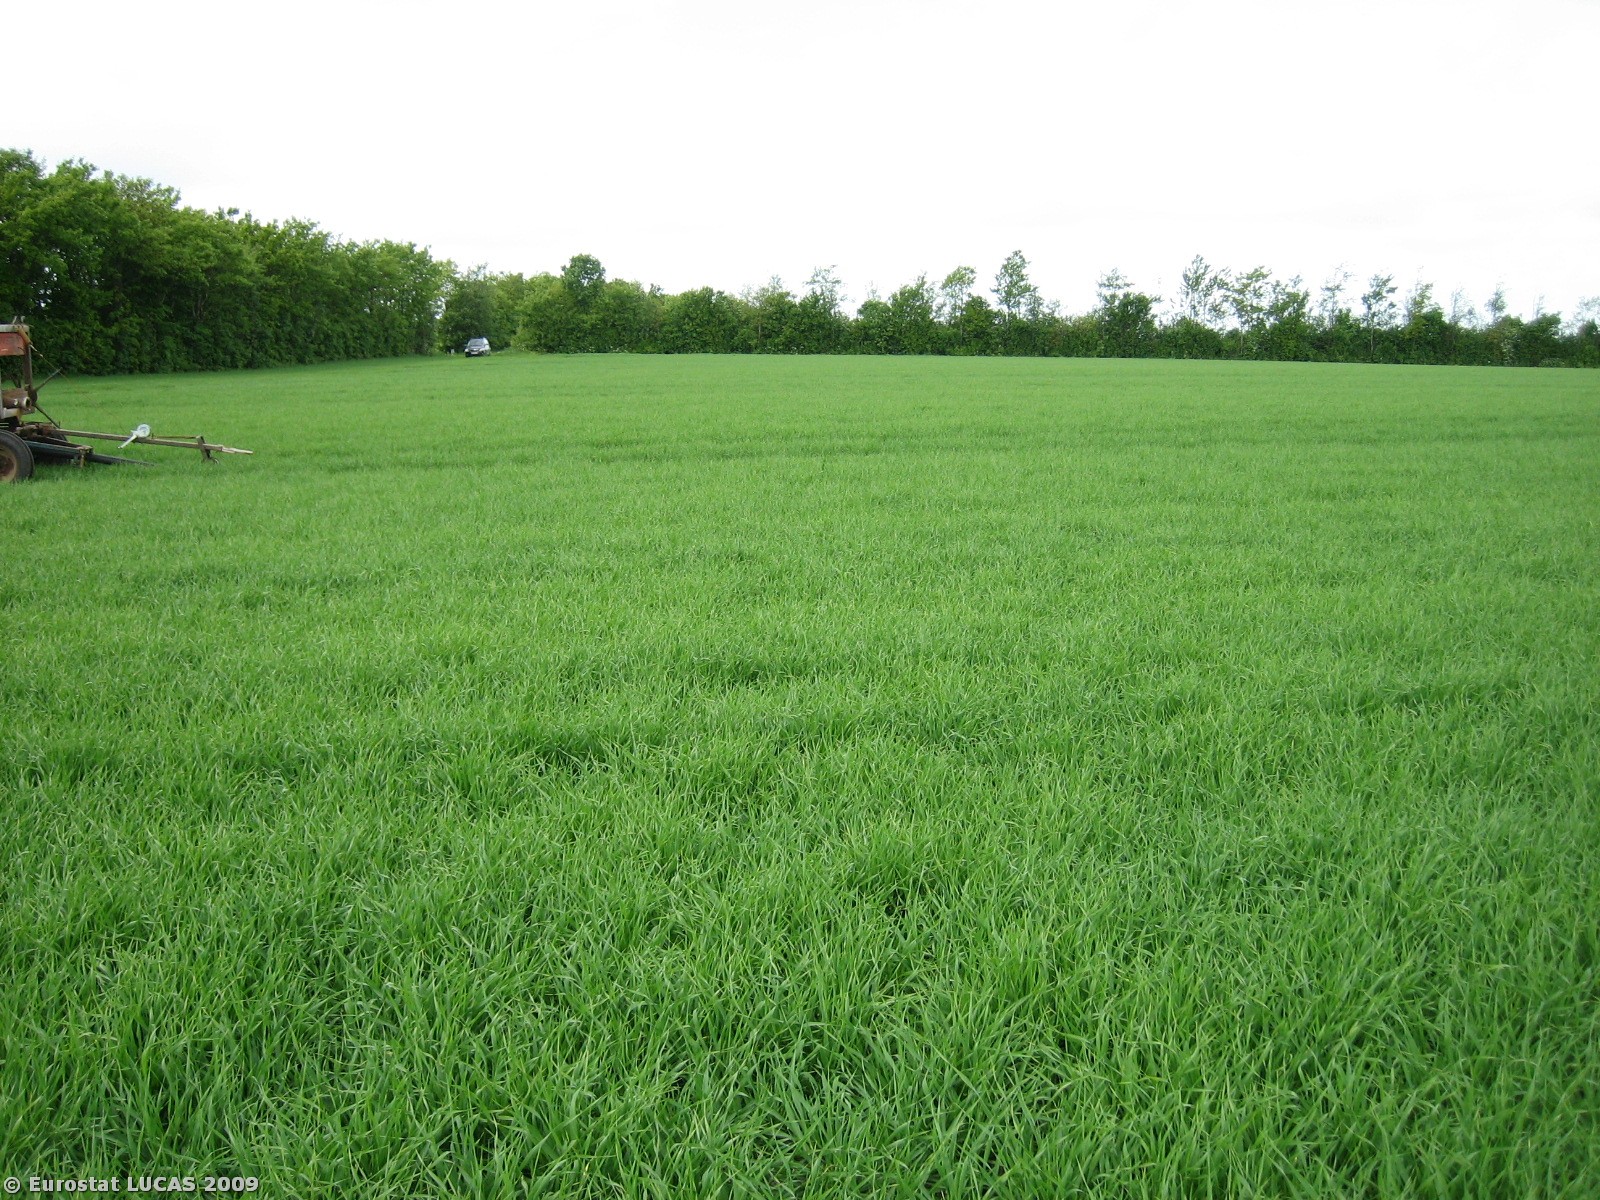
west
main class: Cropland
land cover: Barley
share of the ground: > 75 %
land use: Agriculture (excluding fallow land and kitchen gardens)
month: May
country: DK
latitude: 56.1467
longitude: 8.8585
